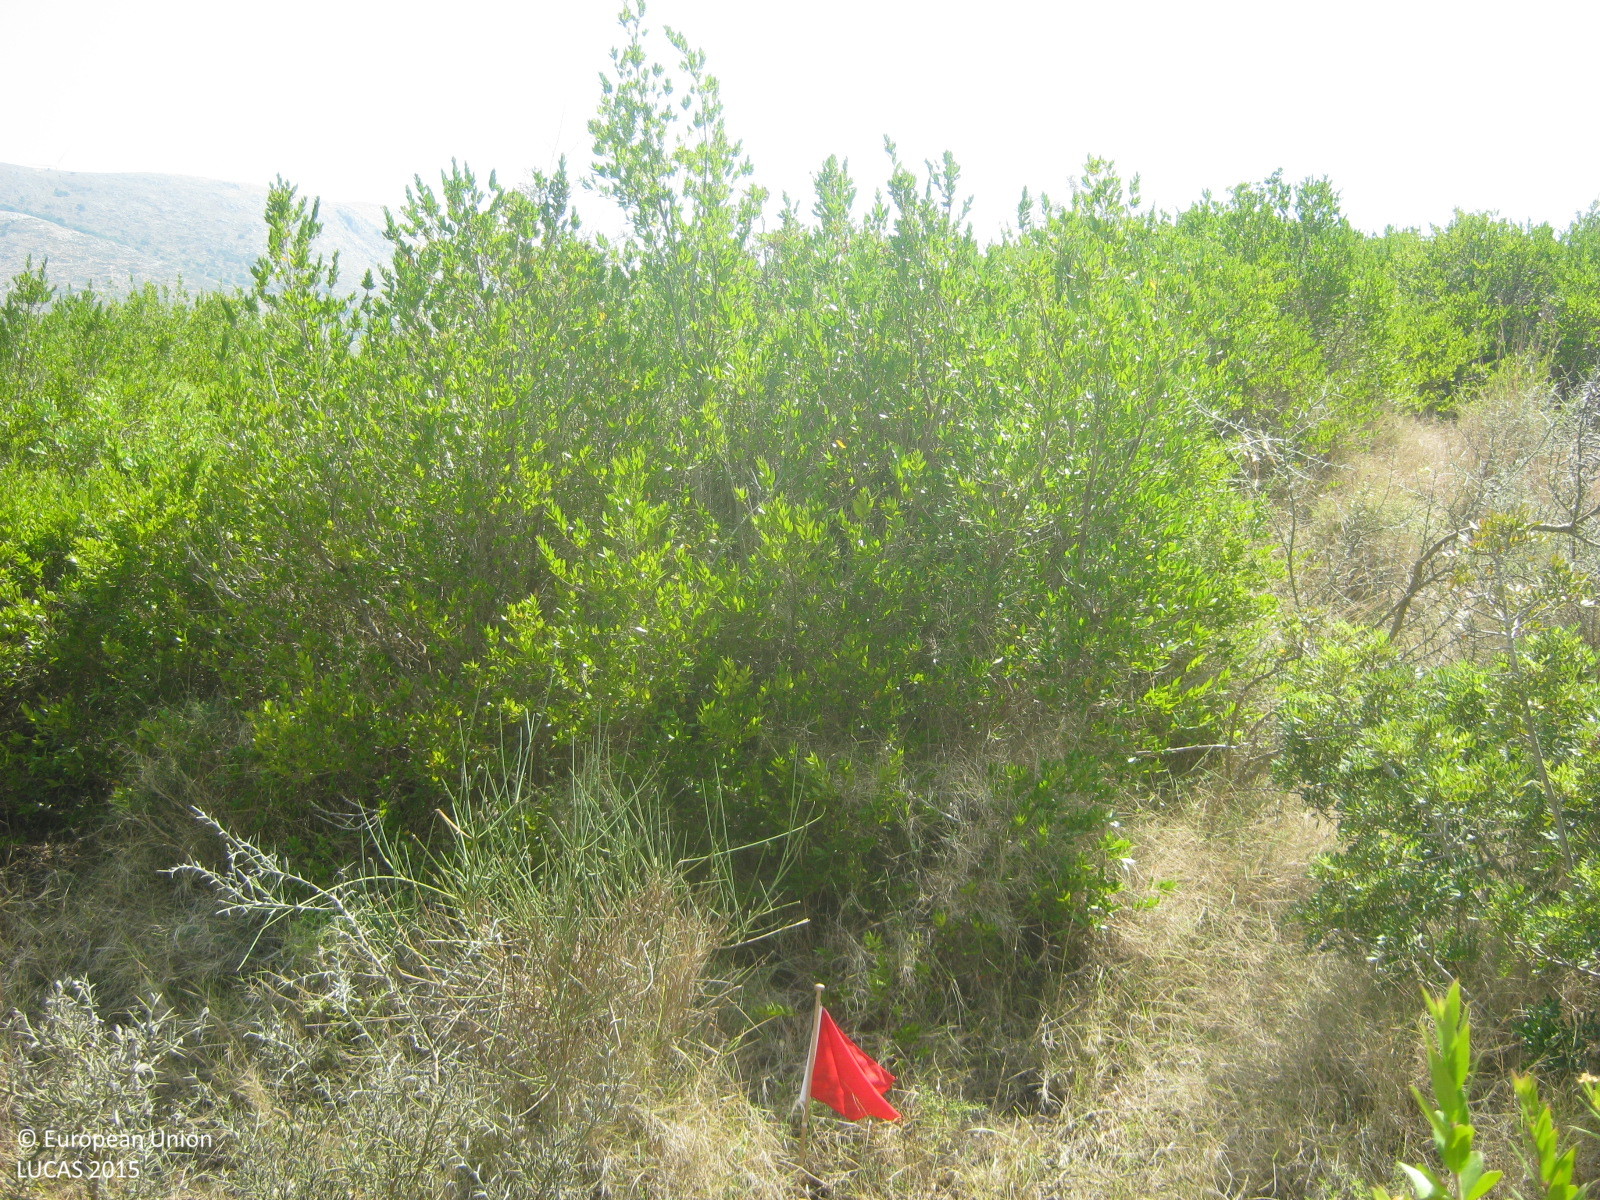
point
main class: Shrubland
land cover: Shrubland without tree cover
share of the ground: > 75 %
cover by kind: shrubs 80 %, herbaceous plants 20 %
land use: Semi-natural and natural areas not in use
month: August
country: GR
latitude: 38.3005
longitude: 20.4707
